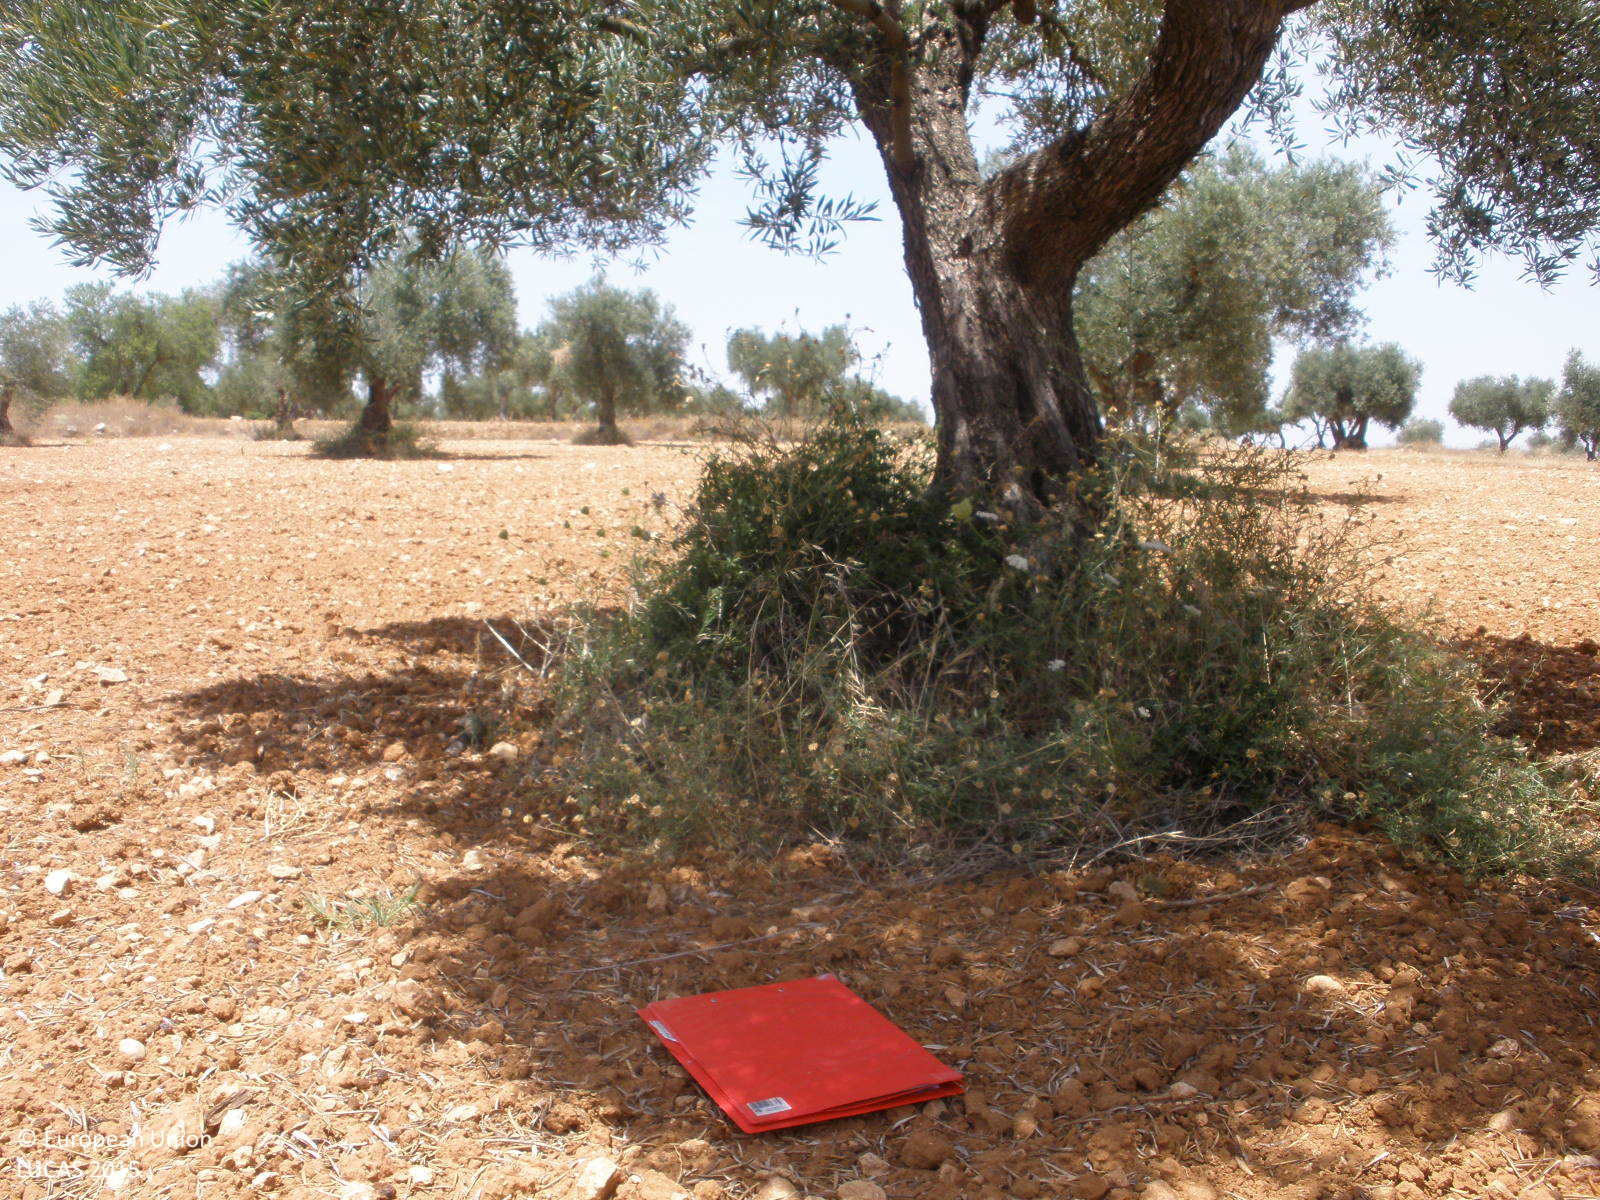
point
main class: Cropland
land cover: Olive groves
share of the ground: 25 - 50 %
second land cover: Other bare soil
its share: > 75 %
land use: Agriculture (excluding fallow land and kitchen gardens)
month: July
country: ES
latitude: 40.2285
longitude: -3.4889
